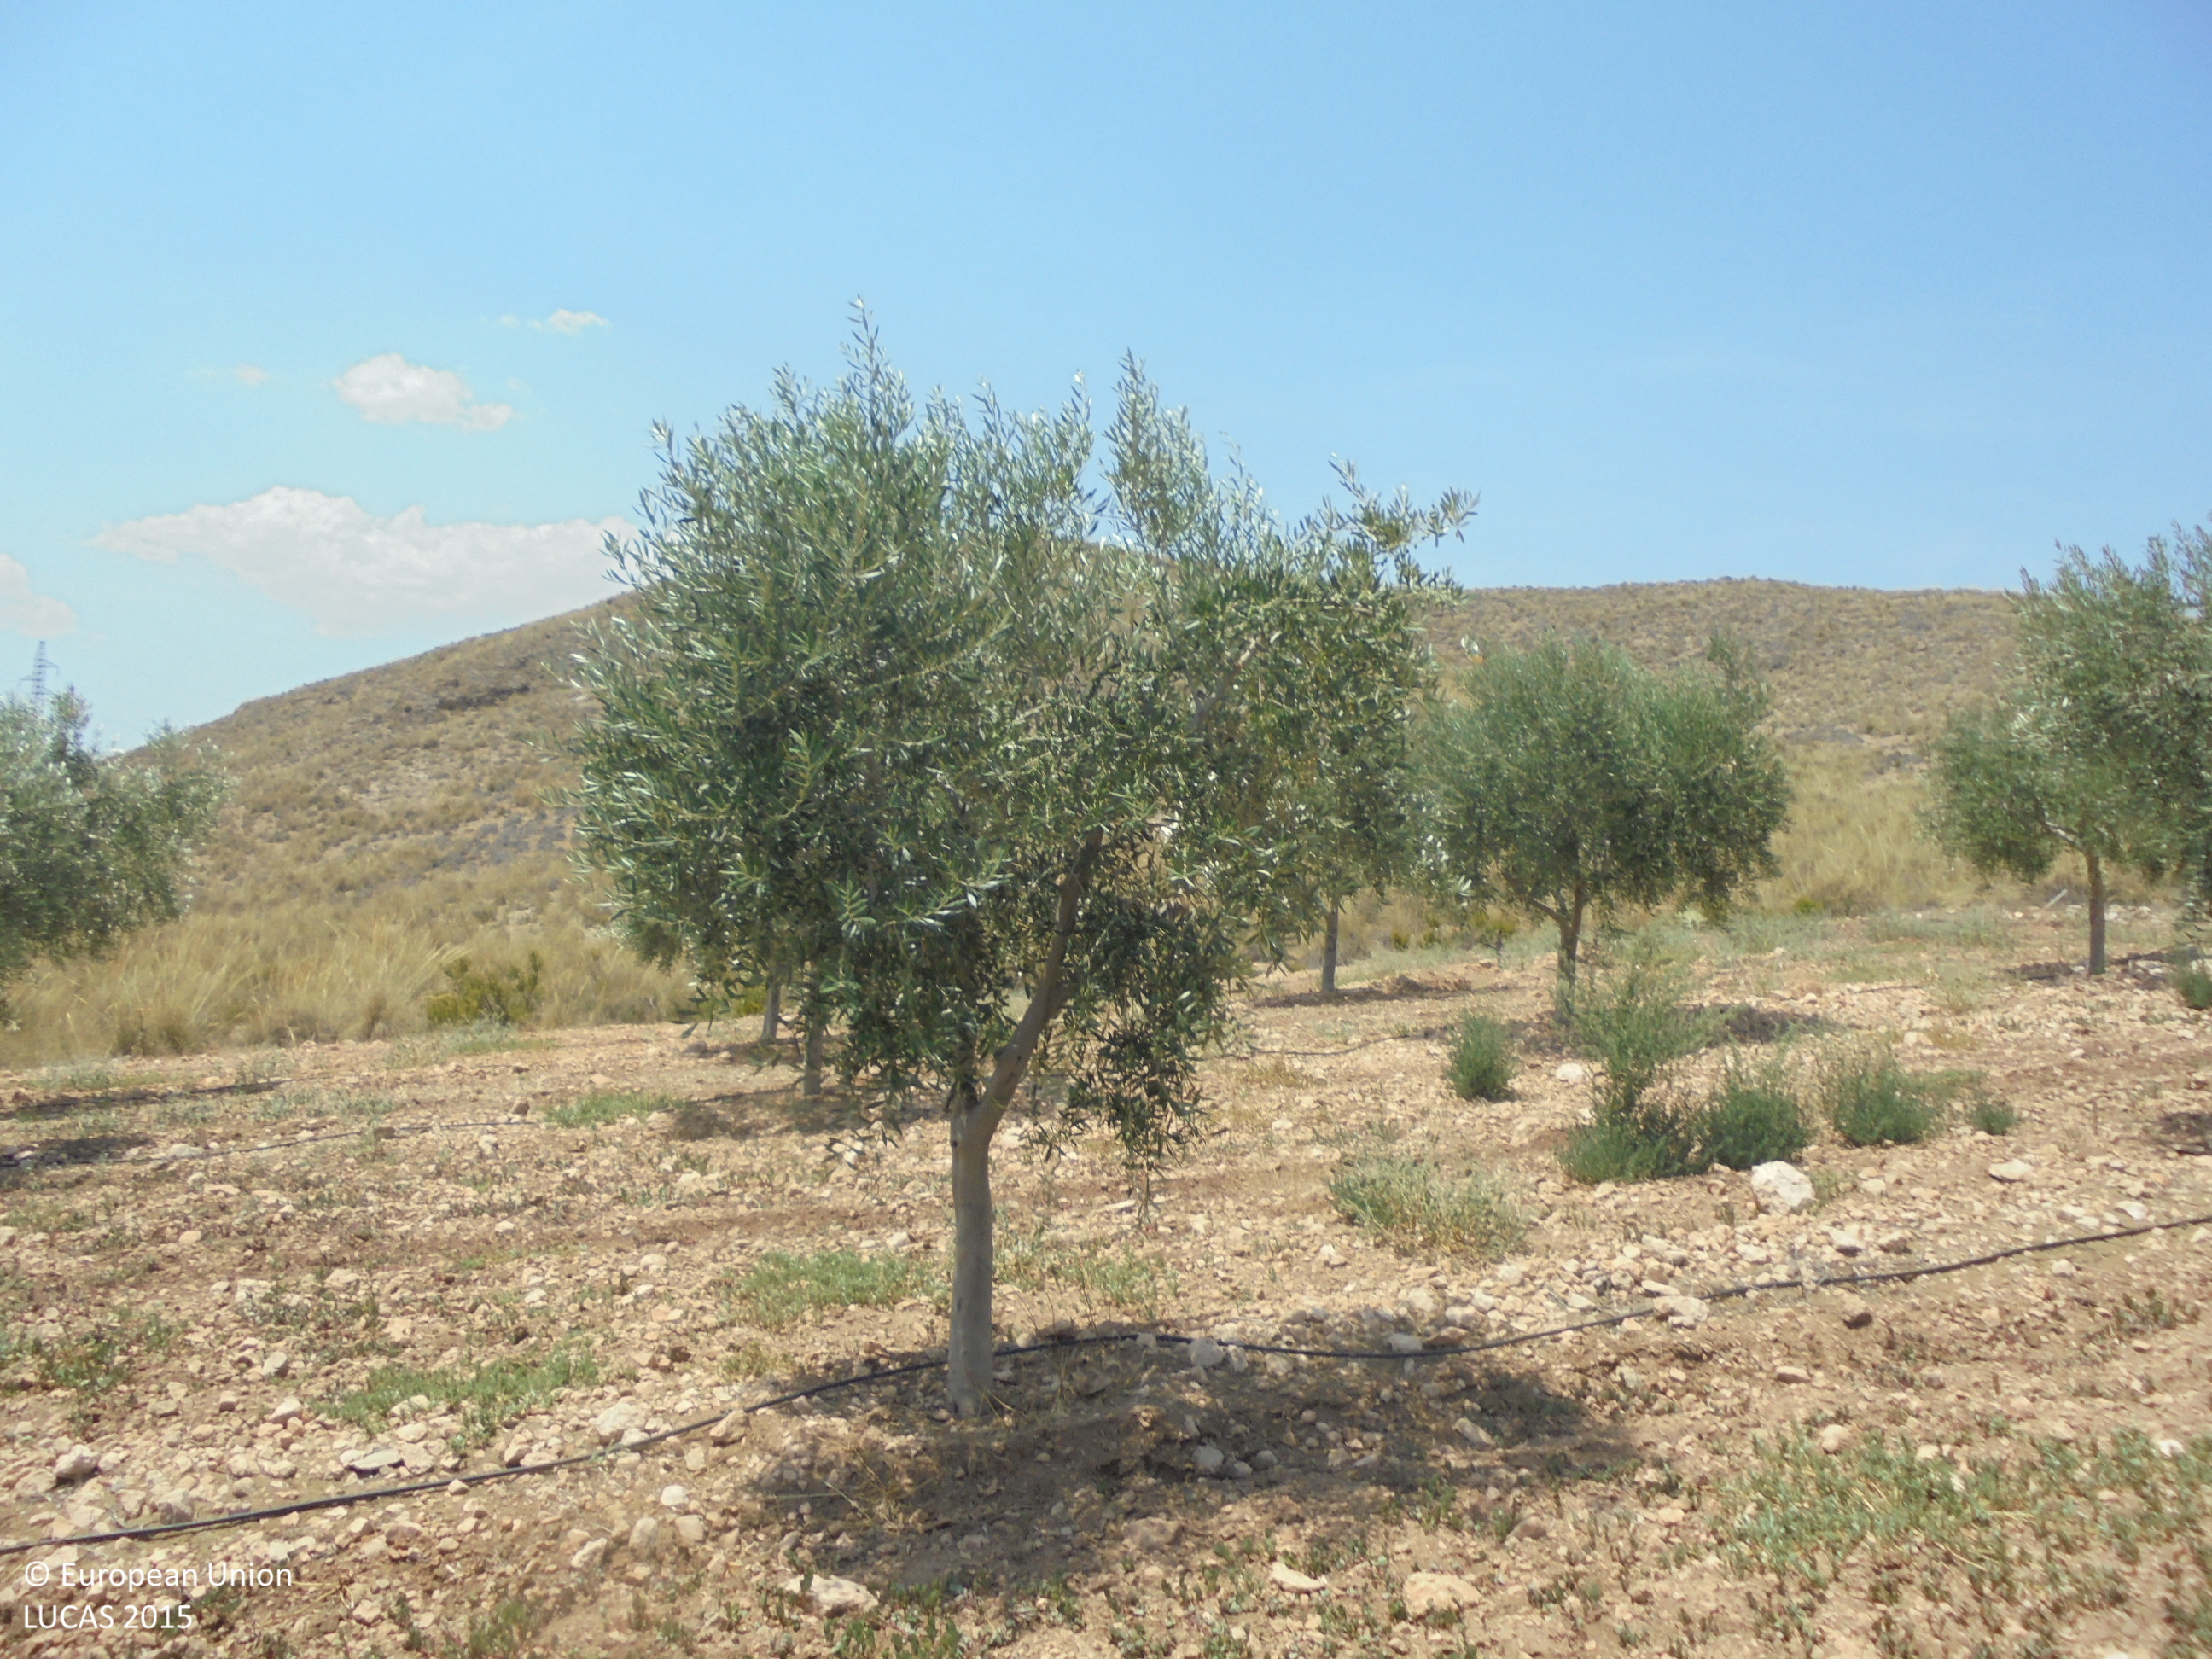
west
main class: Cropland
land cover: Olive groves
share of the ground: 25 - 50 %
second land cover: Spontaneously vegetated surfaces
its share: 50 - 75 %
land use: Agriculture (excluding fallow land and kitchen gardens)
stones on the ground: > 50 %
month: July
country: ES
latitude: 38.5253
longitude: -1.6818
